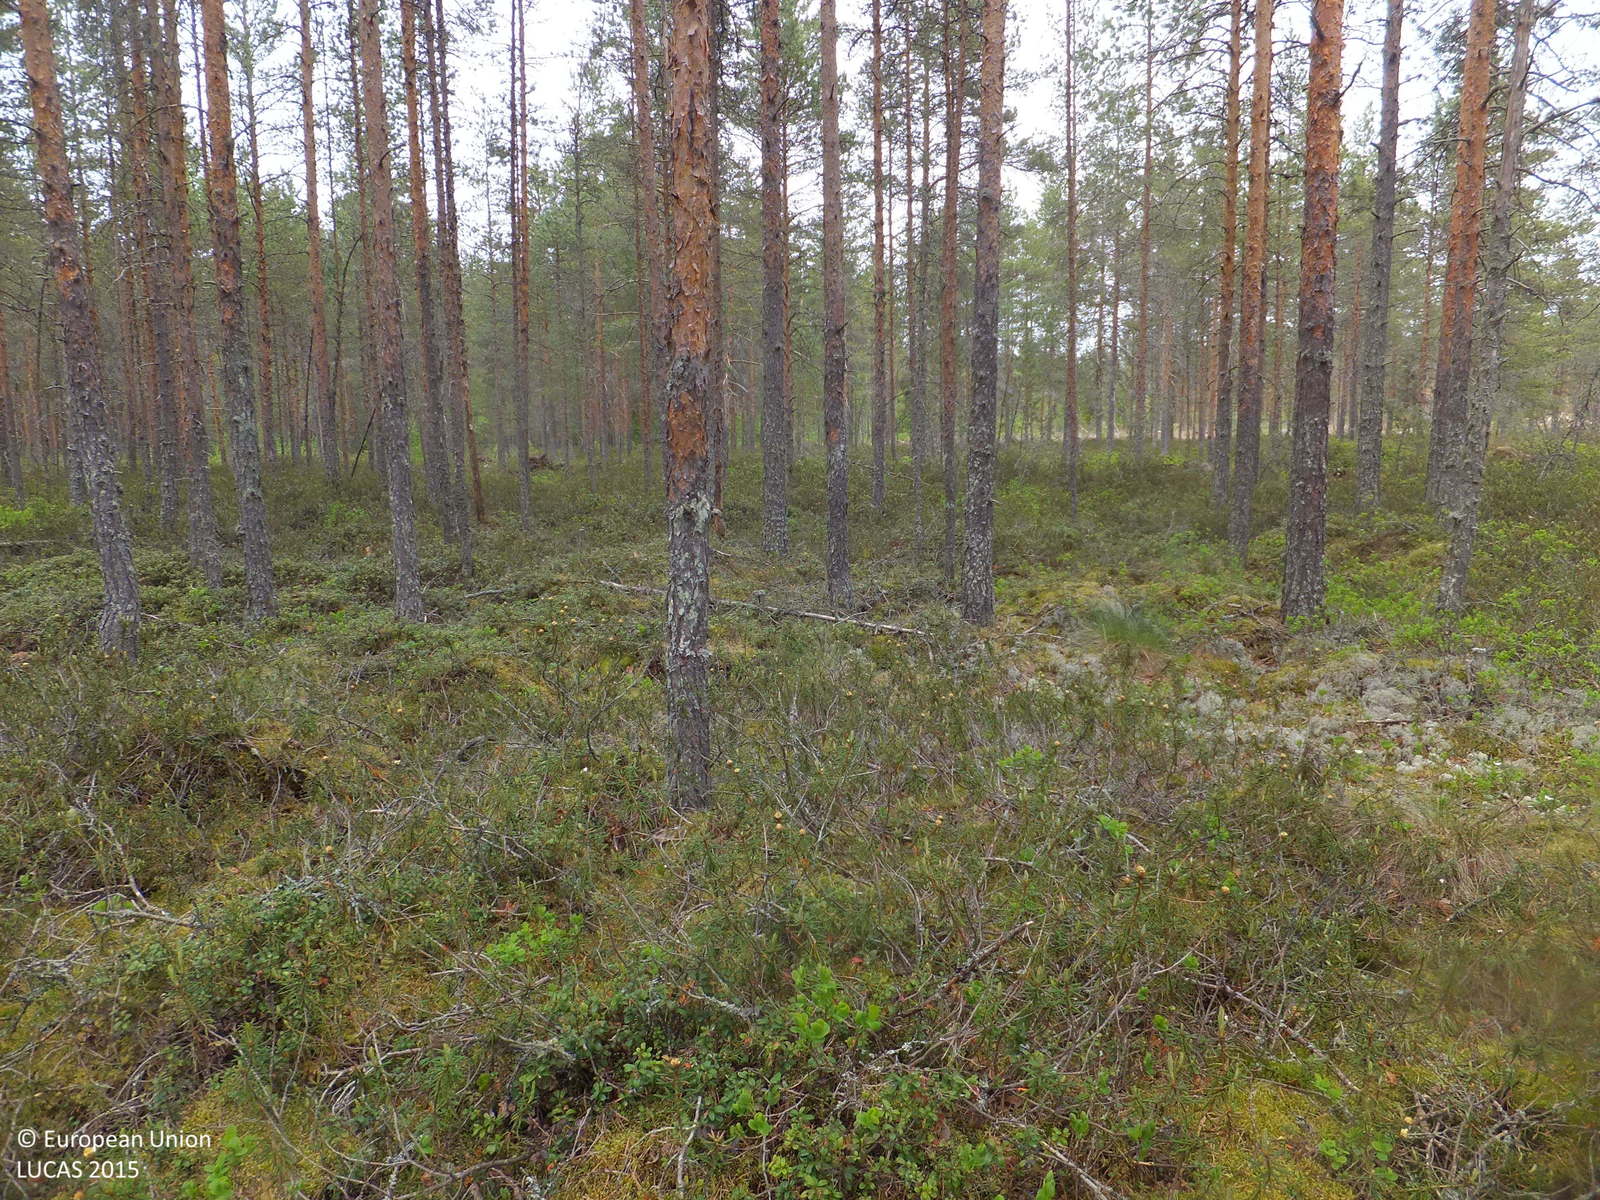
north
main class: Woodland
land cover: Pine dominated coniferous woodland
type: boreal forest
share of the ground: > 75 %
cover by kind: coniferous forest trees 80 %, shrubs 10 %, lichens and mosses 10 %
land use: Forestry
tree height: > 5 m
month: June
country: FI
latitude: 63.2589
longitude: 22.7418
